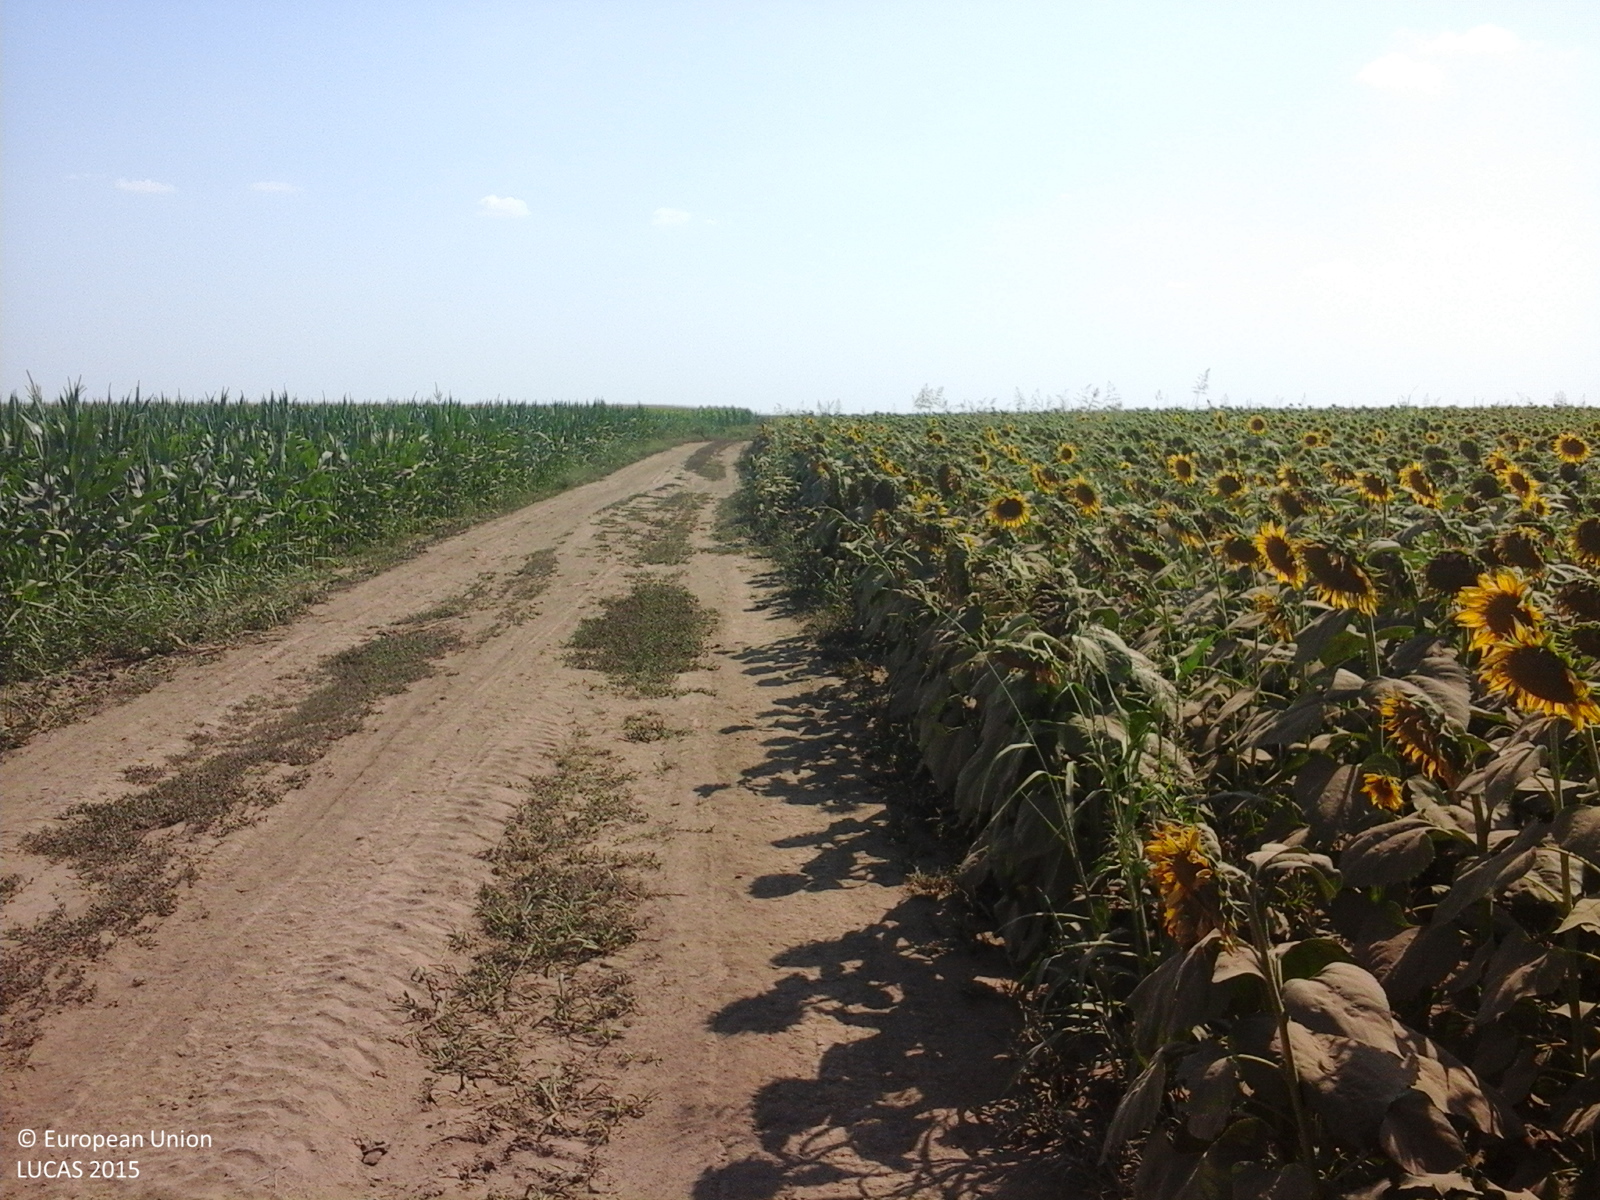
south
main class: Cropland
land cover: Maize
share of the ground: > 75 %
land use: Agriculture (excluding fallow land and kitchen gardens)
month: July
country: RO
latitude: 45.0443
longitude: 26.9290
